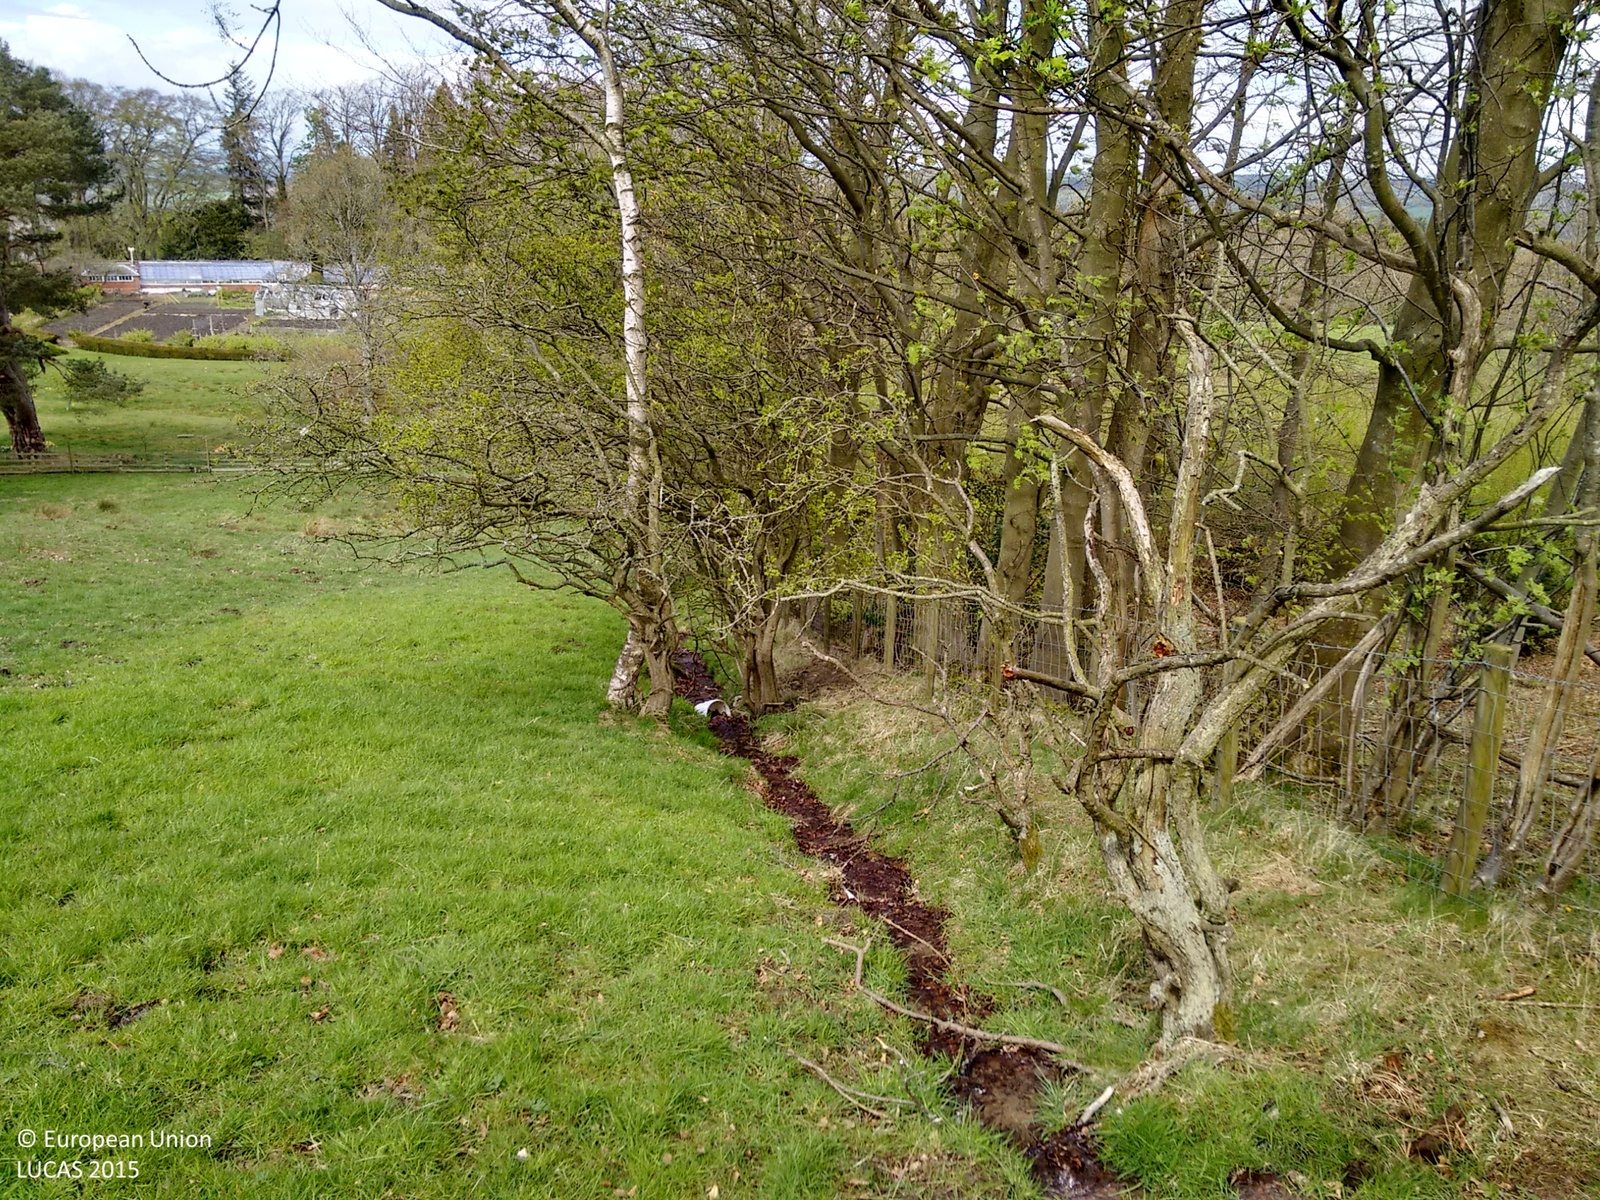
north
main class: Woodland
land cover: Broadleaved woodland
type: acidophilous oak and oak-birch forest
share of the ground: > 75 %
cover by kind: broadleaved forest trees 100 %
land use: Forestry
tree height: > 5 m
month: May
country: GB
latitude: 54.9577
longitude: -2.0965
